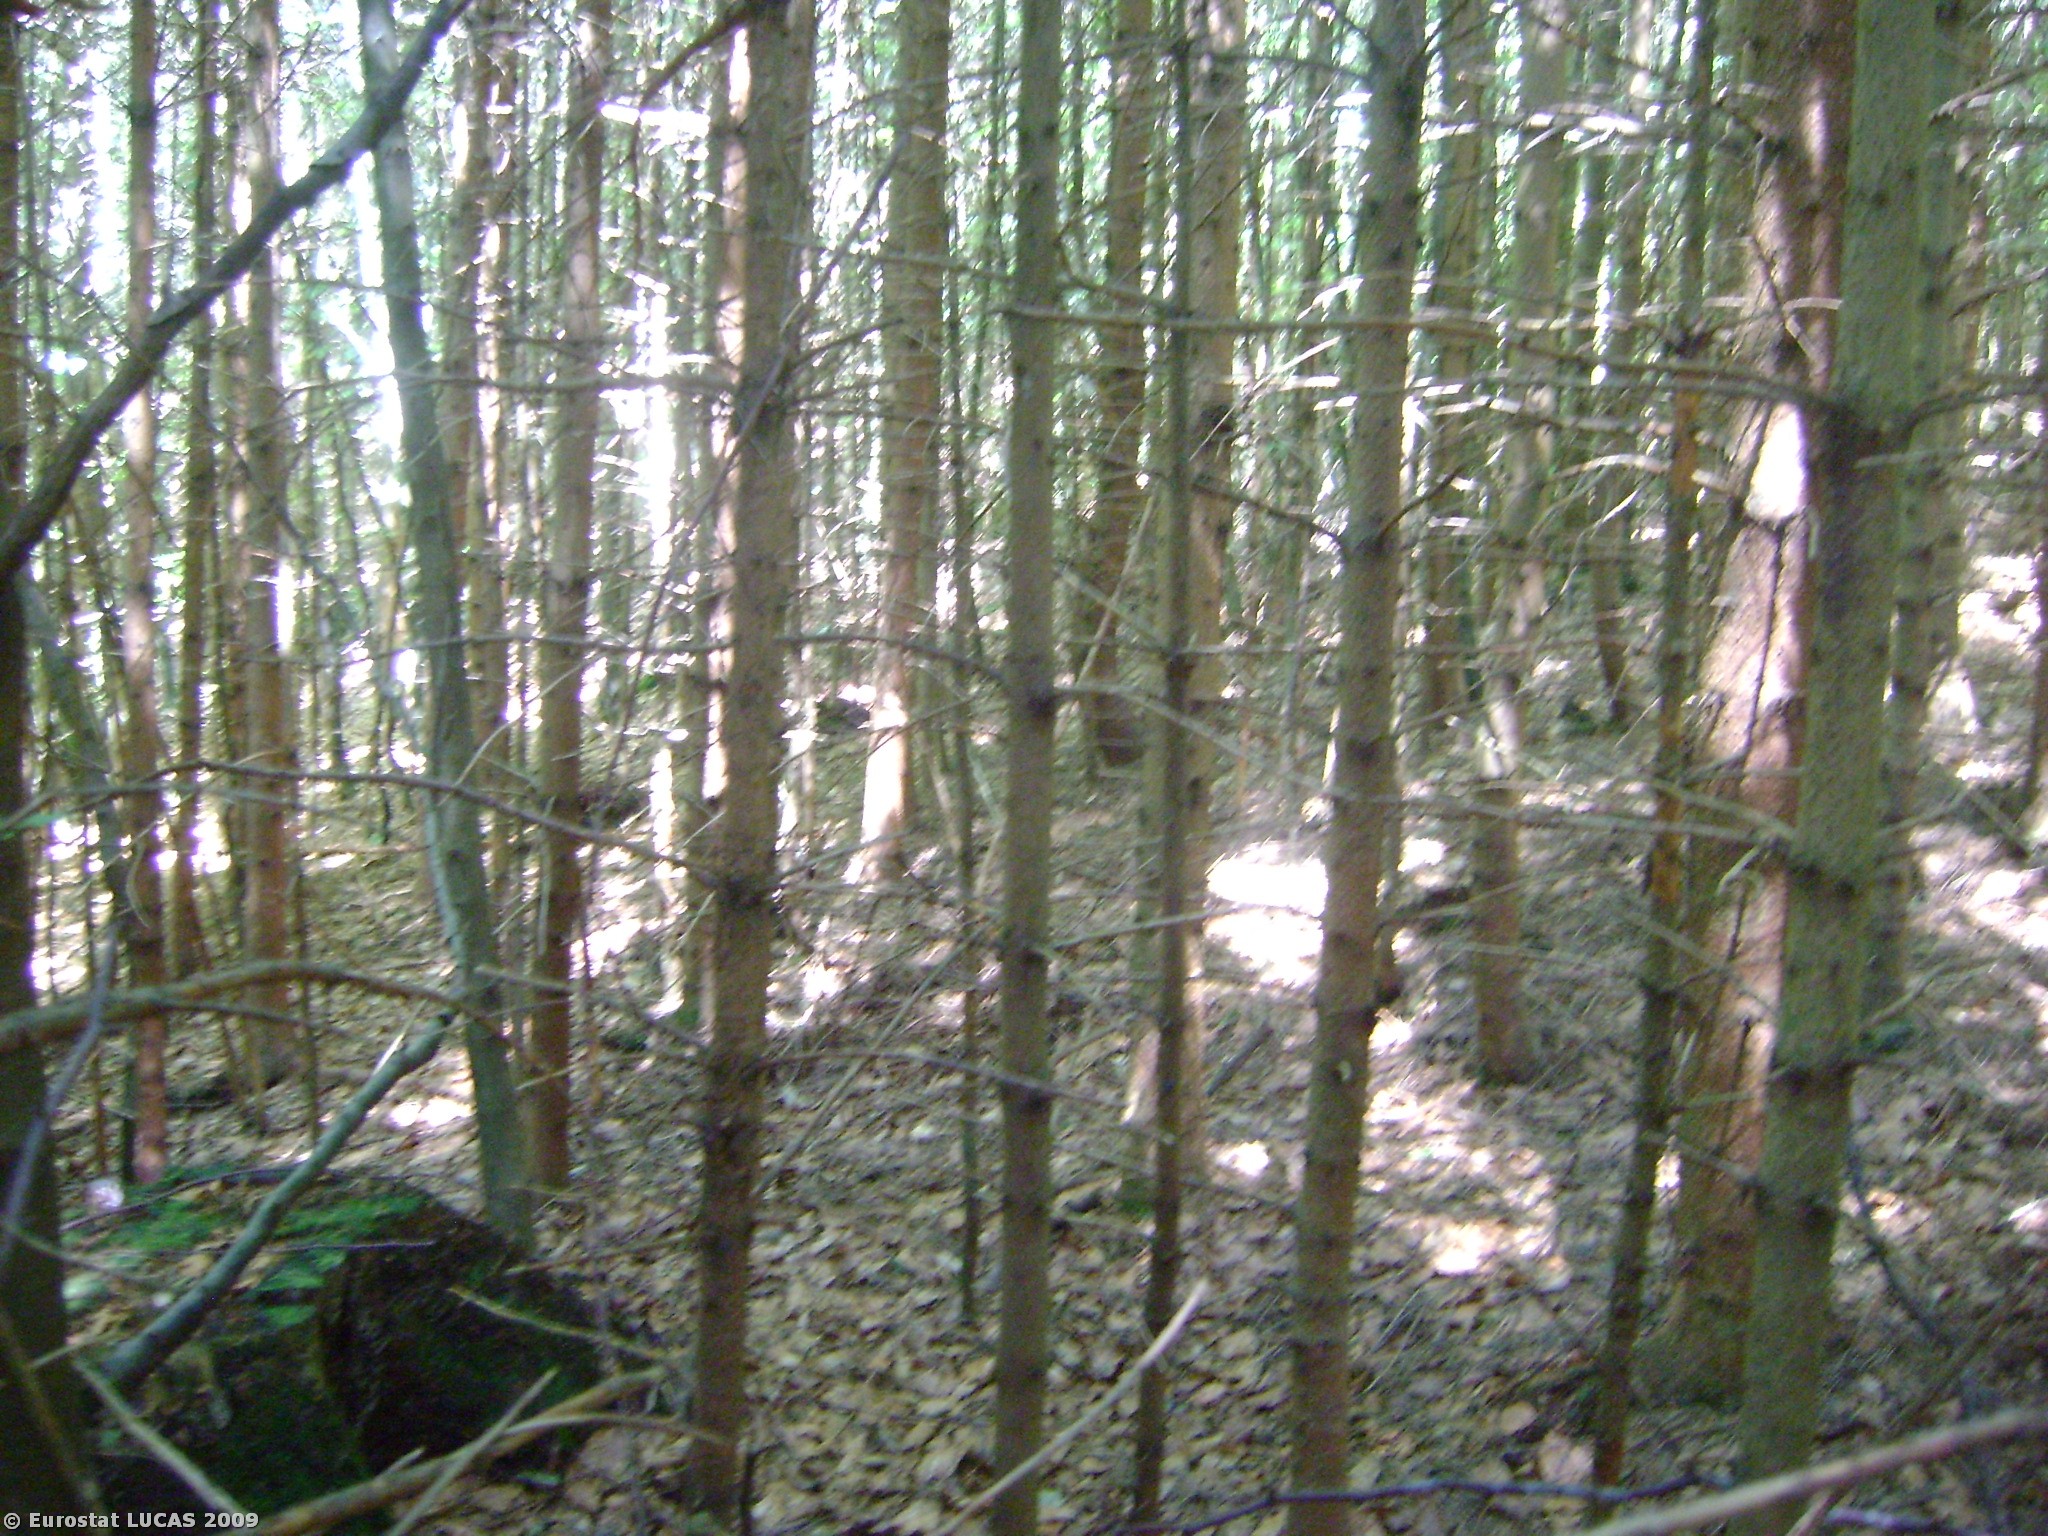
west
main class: Woodland
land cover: Mixed woodland
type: hemiboreal forest and nemoral coniferous forest and mixed broadleaved-coniferous forest
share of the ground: > 75 %
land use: Forestry
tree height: > 5 m
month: June
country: AT
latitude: 48.0298
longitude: 13.3113
